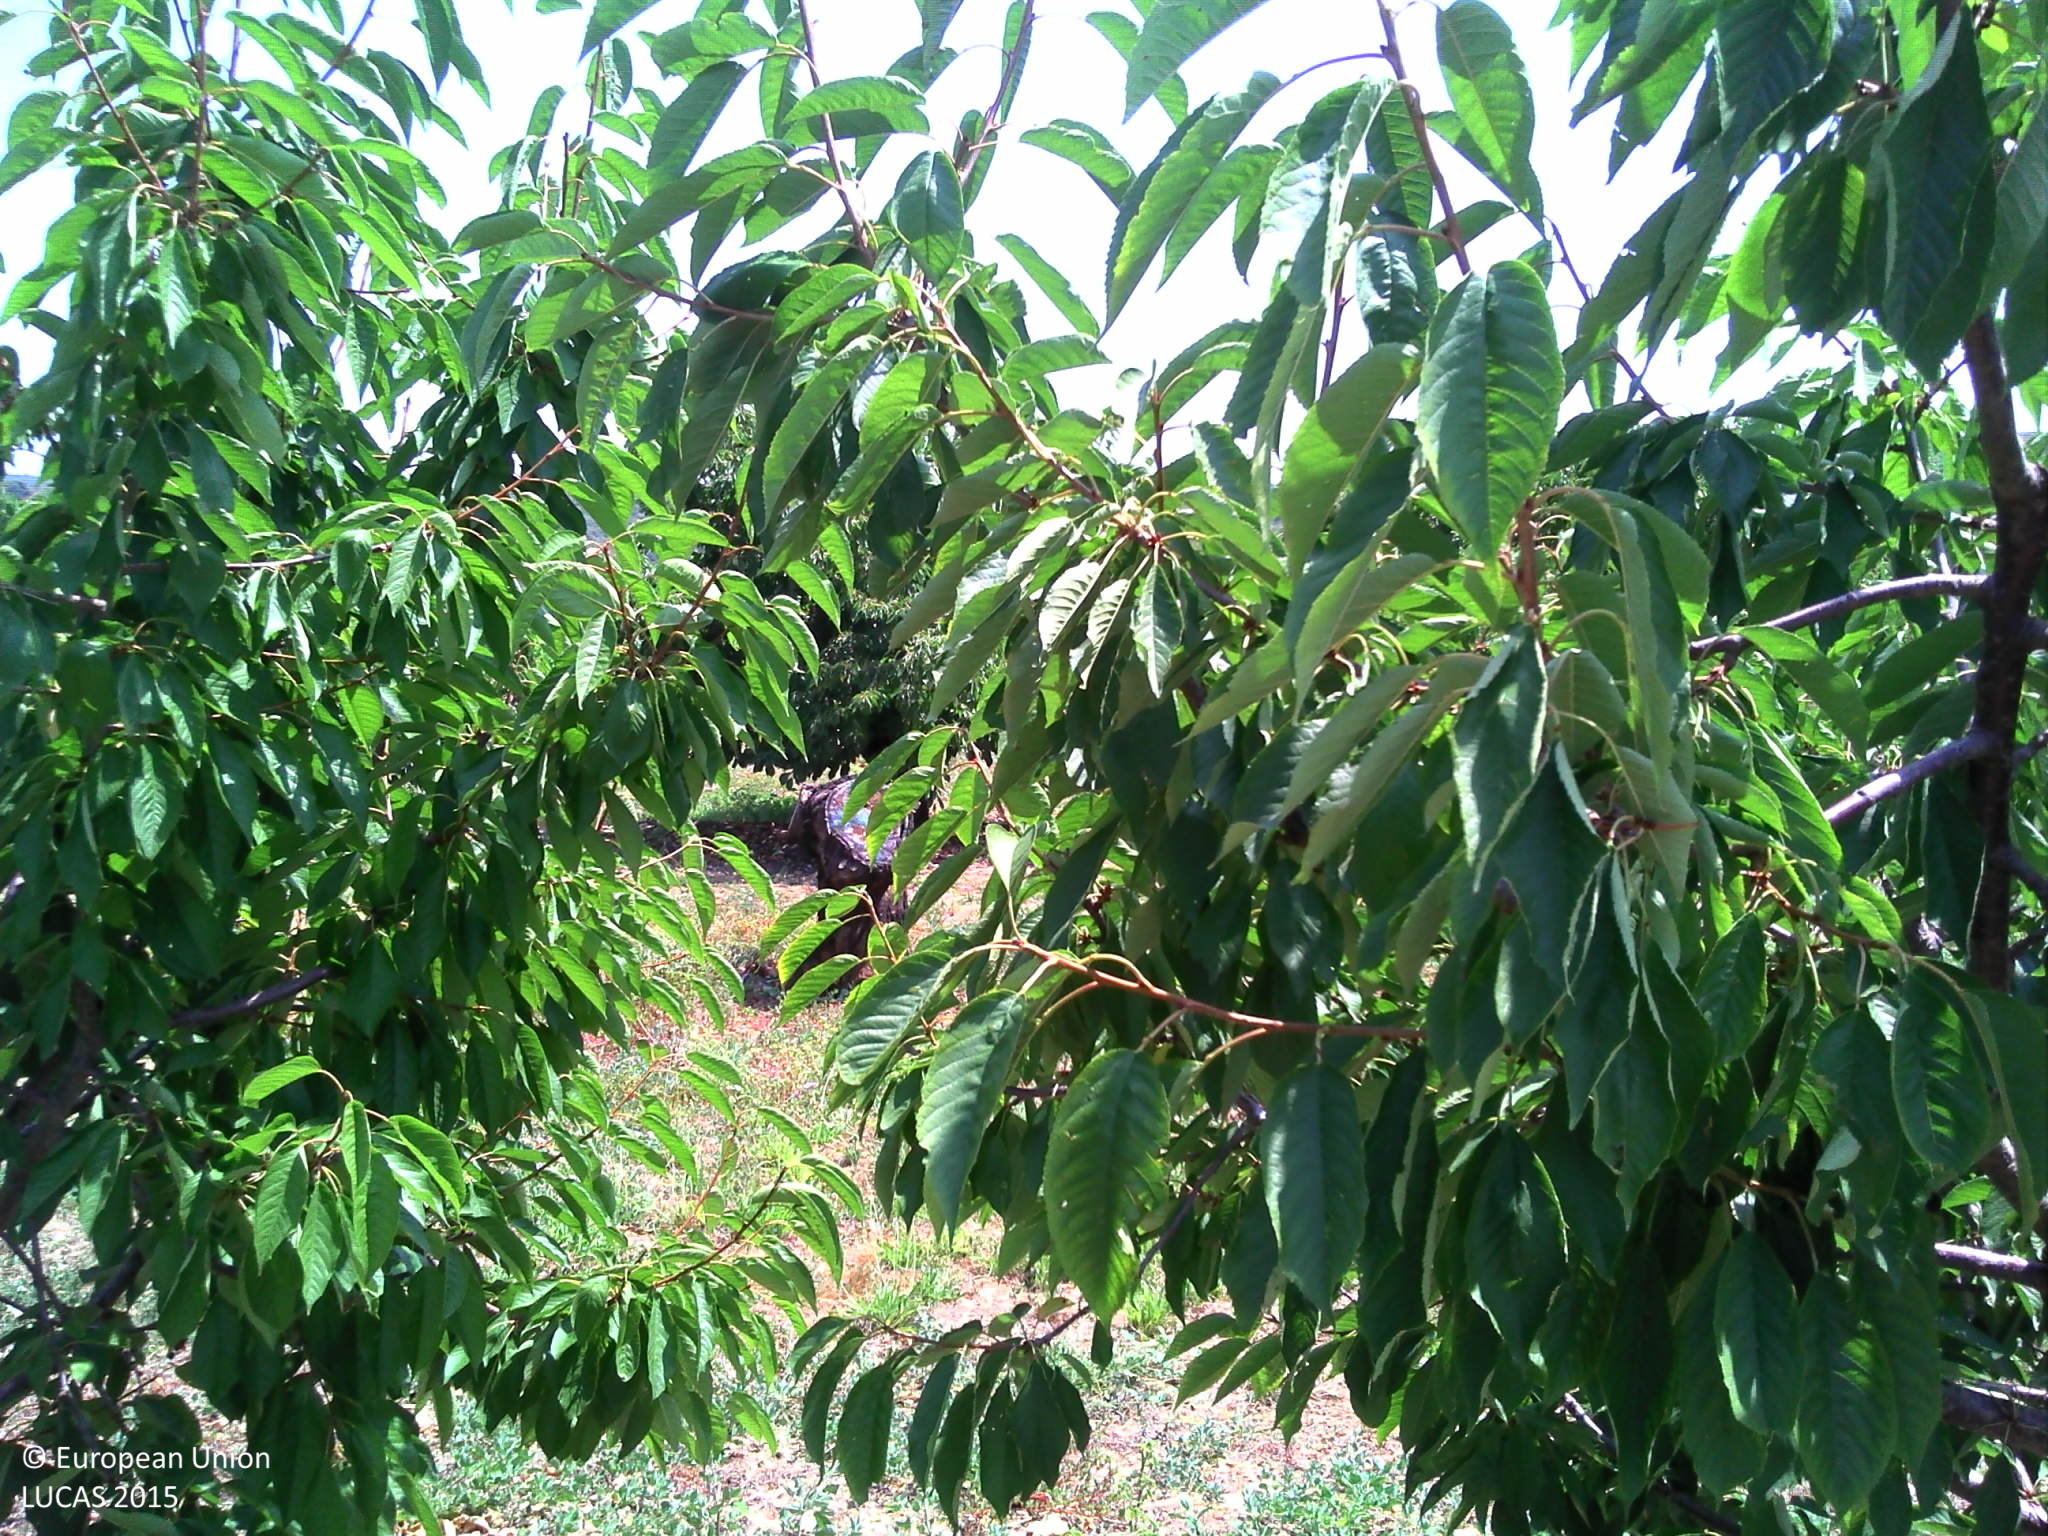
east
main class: Cropland
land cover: Cherry fruit
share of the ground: 50 - 75 %
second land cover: Grassland without tree/shrub cover
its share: 50 - 75 %
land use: Agriculture (excluding fallow land and kitchen gardens)
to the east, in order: Cherry fruit; Grassland without tree/shrub cover; Fences; Vineyards; Cherry fruit; Vineyards; Tracks; Grass margins; Vineyards
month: July
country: FR
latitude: 44.0421
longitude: 5.2286
